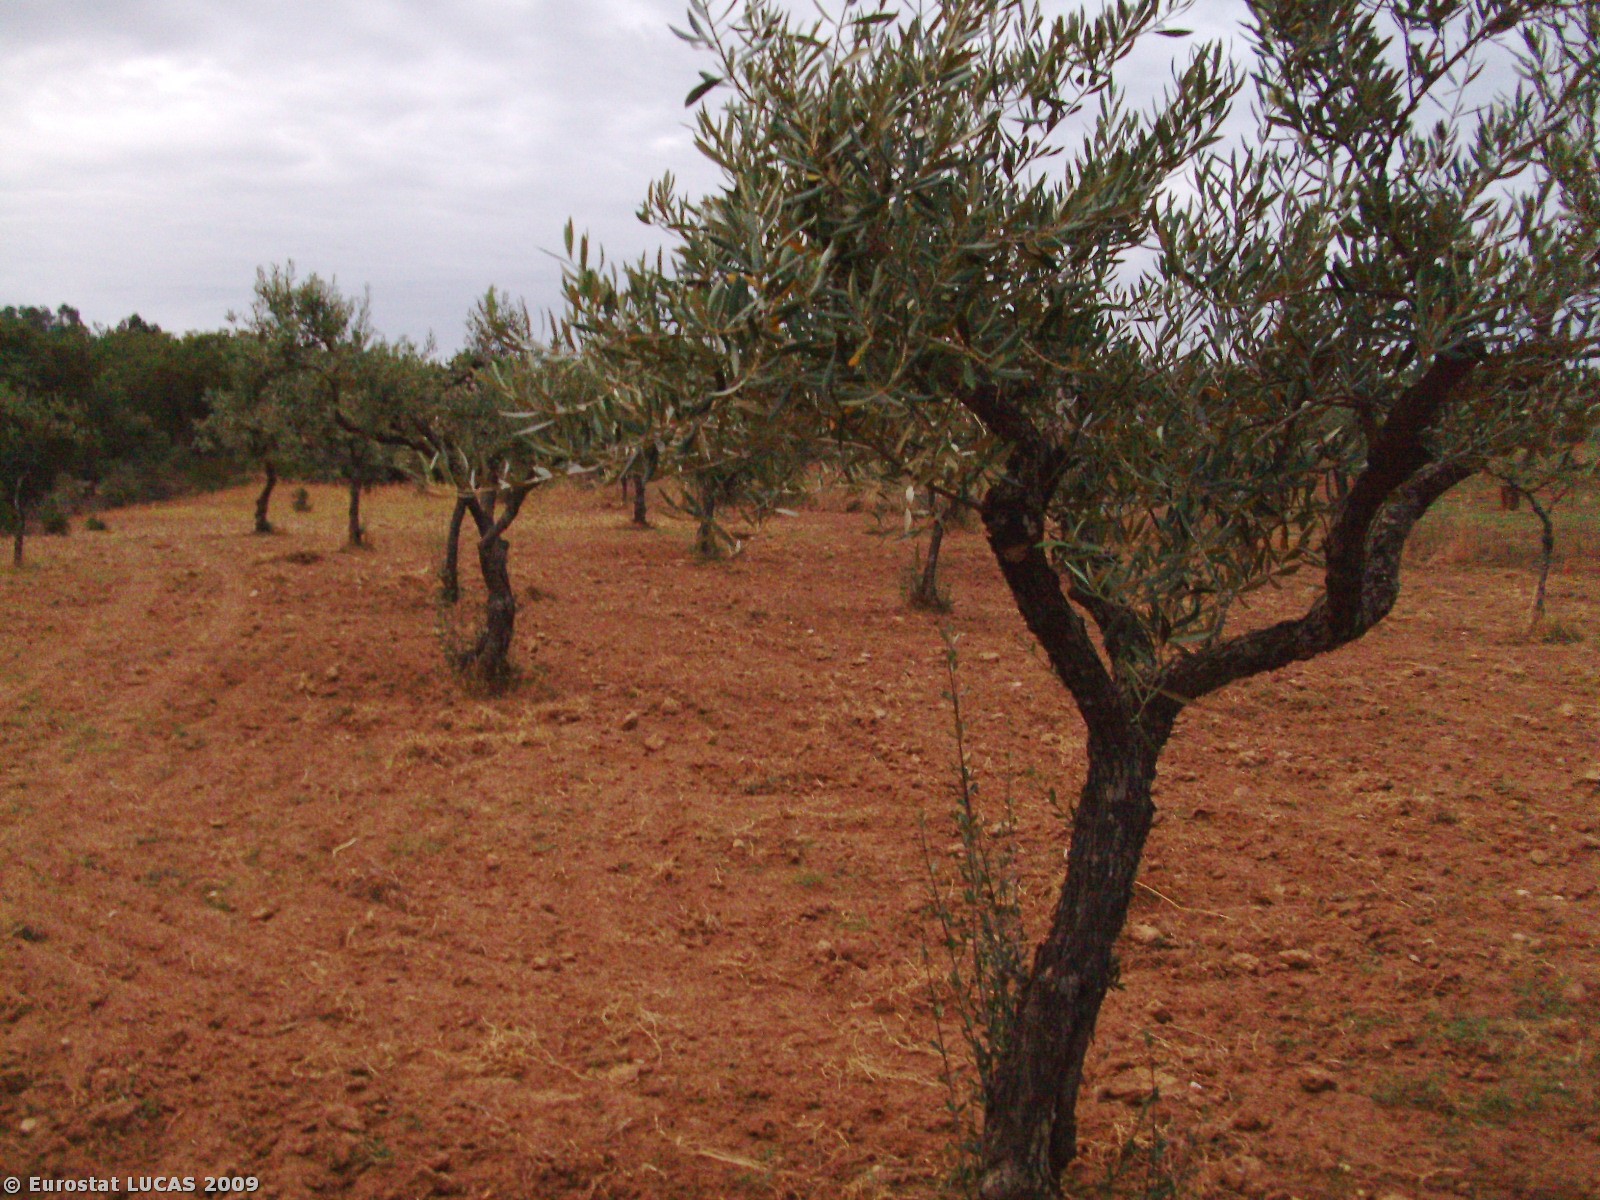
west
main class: Cropland
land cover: Olive groves
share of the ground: 50 - 75 %
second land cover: Bare land
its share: 25 - 50 %
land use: Agriculture (excluding fallow land and kitchen gardens)
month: June
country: PT
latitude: 39.9229
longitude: -7.5710
